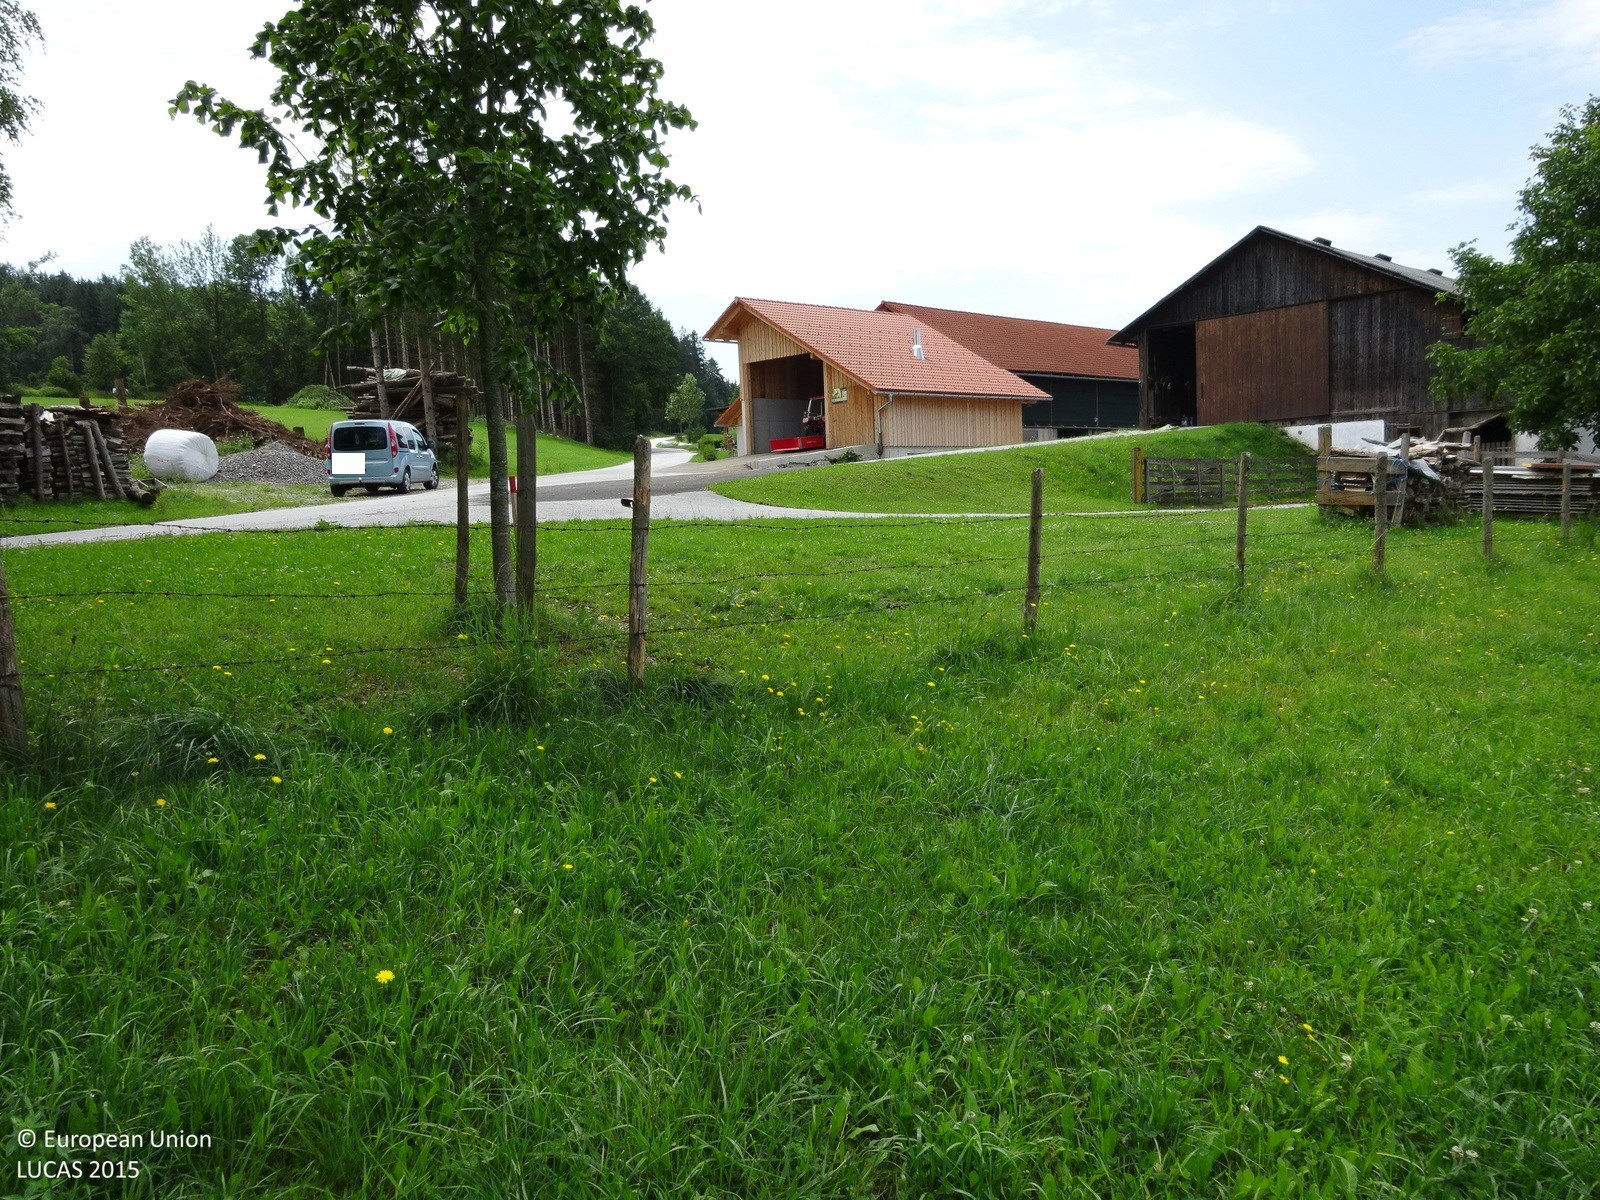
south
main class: Grassland
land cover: Grassland without tree/shrub cover
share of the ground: > 75 %
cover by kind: herbaceous plants 100 %
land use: Agriculture (excluding fallow land and kitchen gardens)
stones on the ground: < 10 %
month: July
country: AT
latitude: 47.2739
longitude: 15.5127
